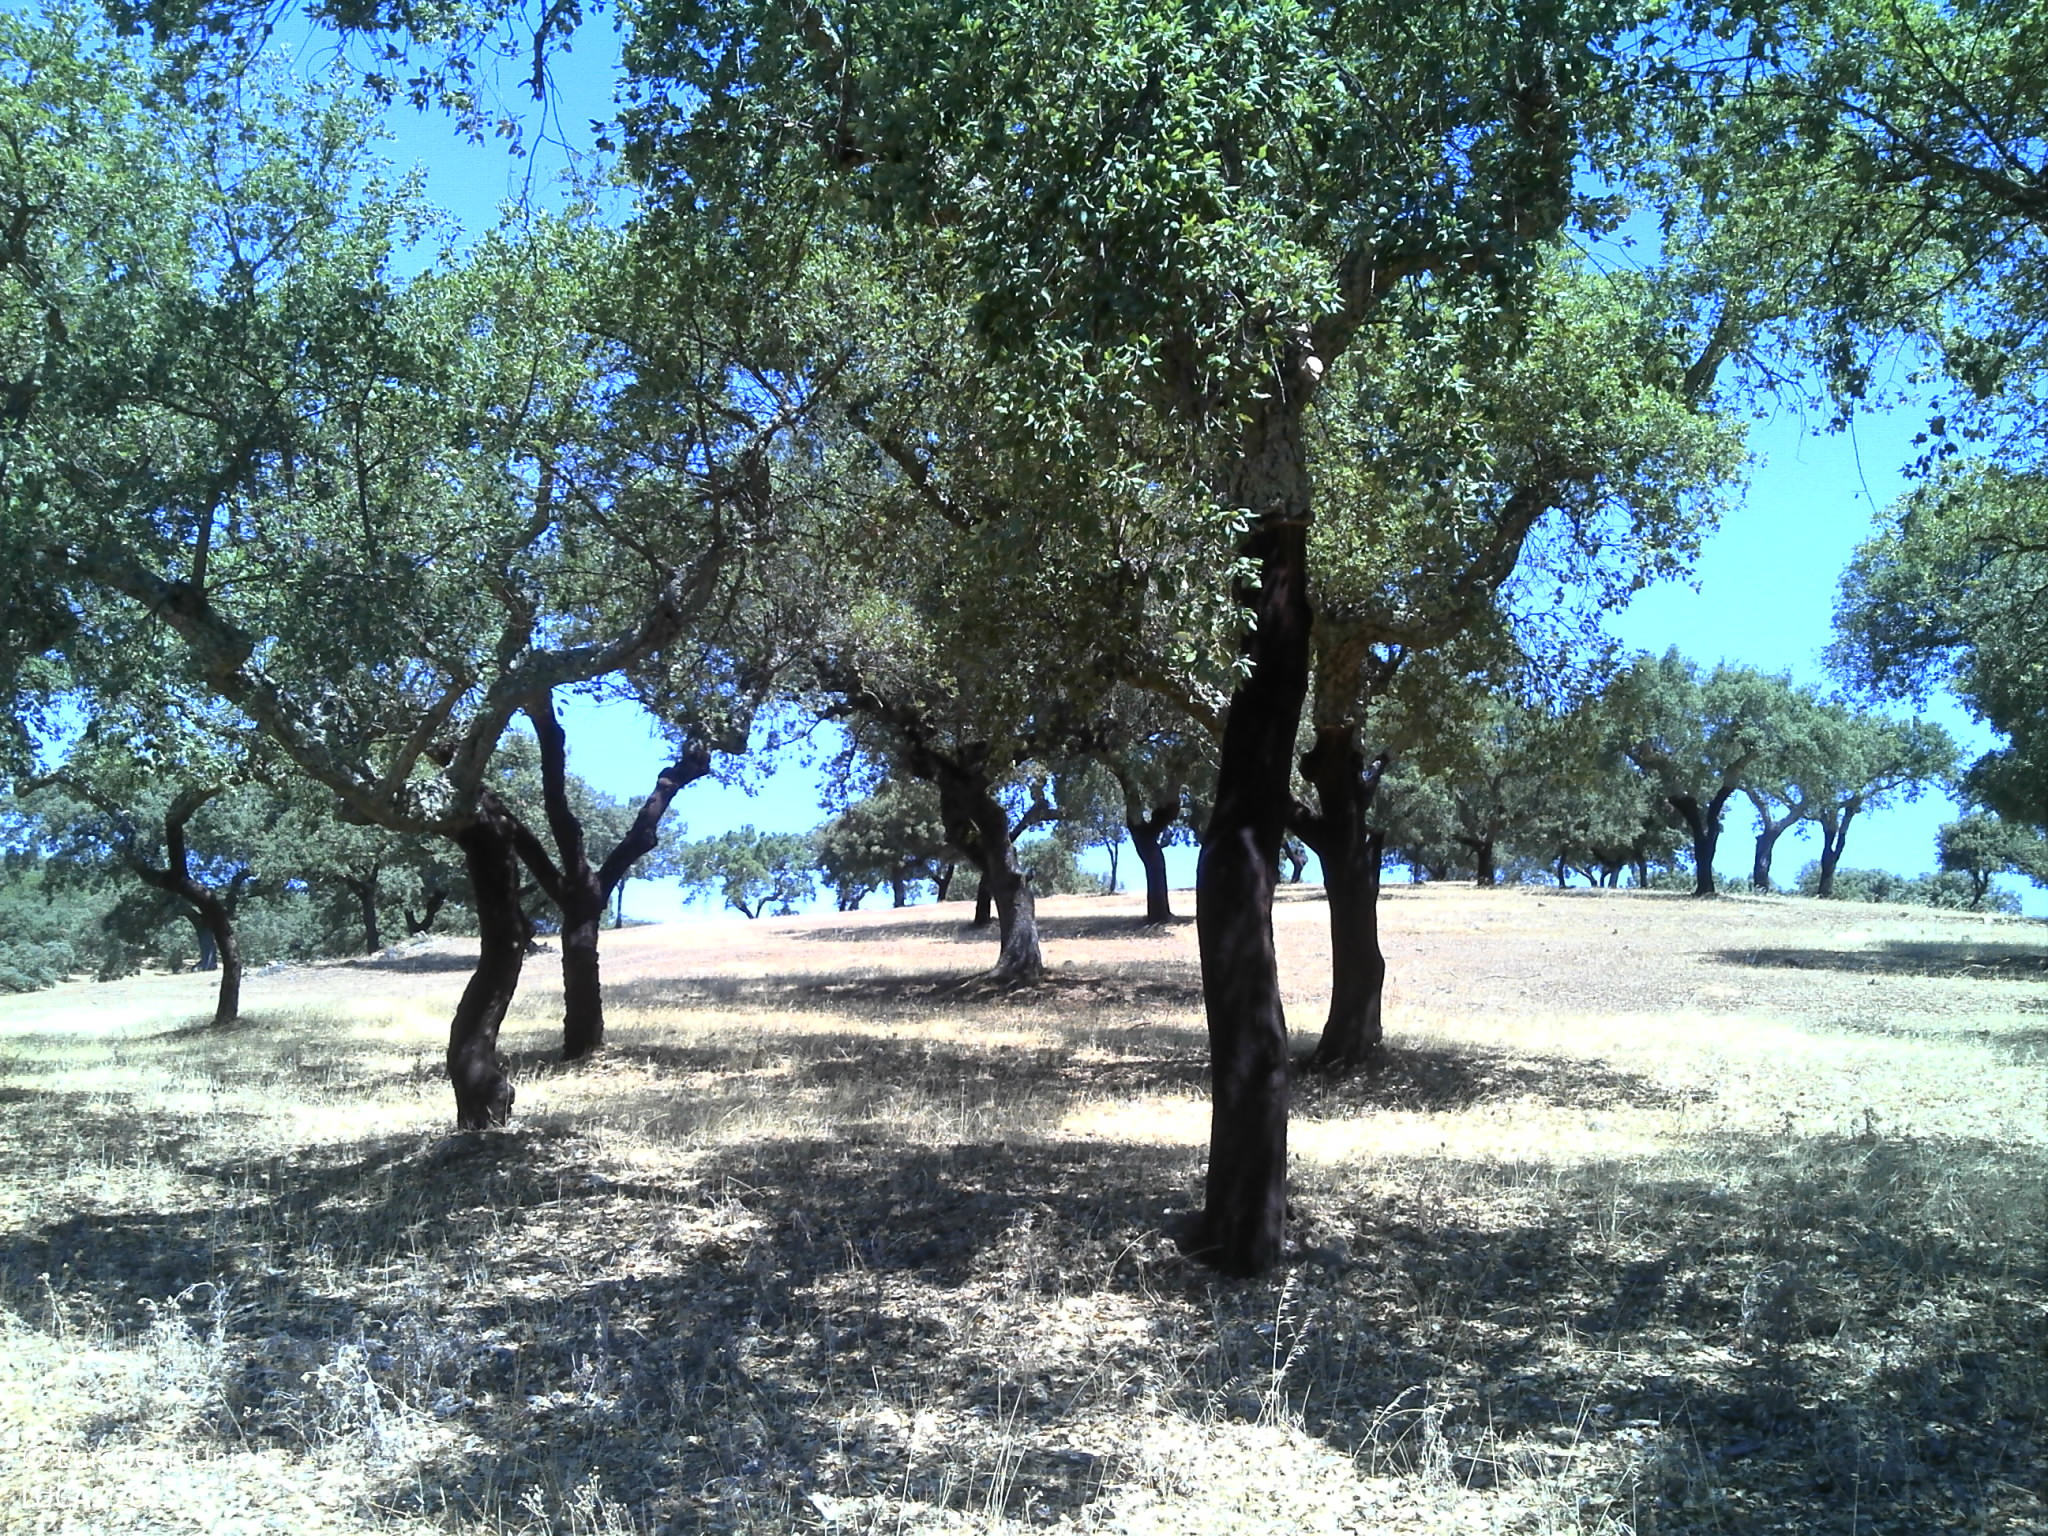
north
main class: Woodland
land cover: Broadleaved woodland
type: broadleaved evergreen forest
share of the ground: 50 - 75 %
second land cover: Grassland without tree/shrub cover
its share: 10 - 25 %
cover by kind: broadleaved forest trees 60 %, herbaceous plants 20 %, unconsolidated bare surface 20 %
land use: Forestry
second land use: Agriculture (excluding fallow land and kitchen gardens)
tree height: > 5 m
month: July
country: PT
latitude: 39.1536
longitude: -7.3365
